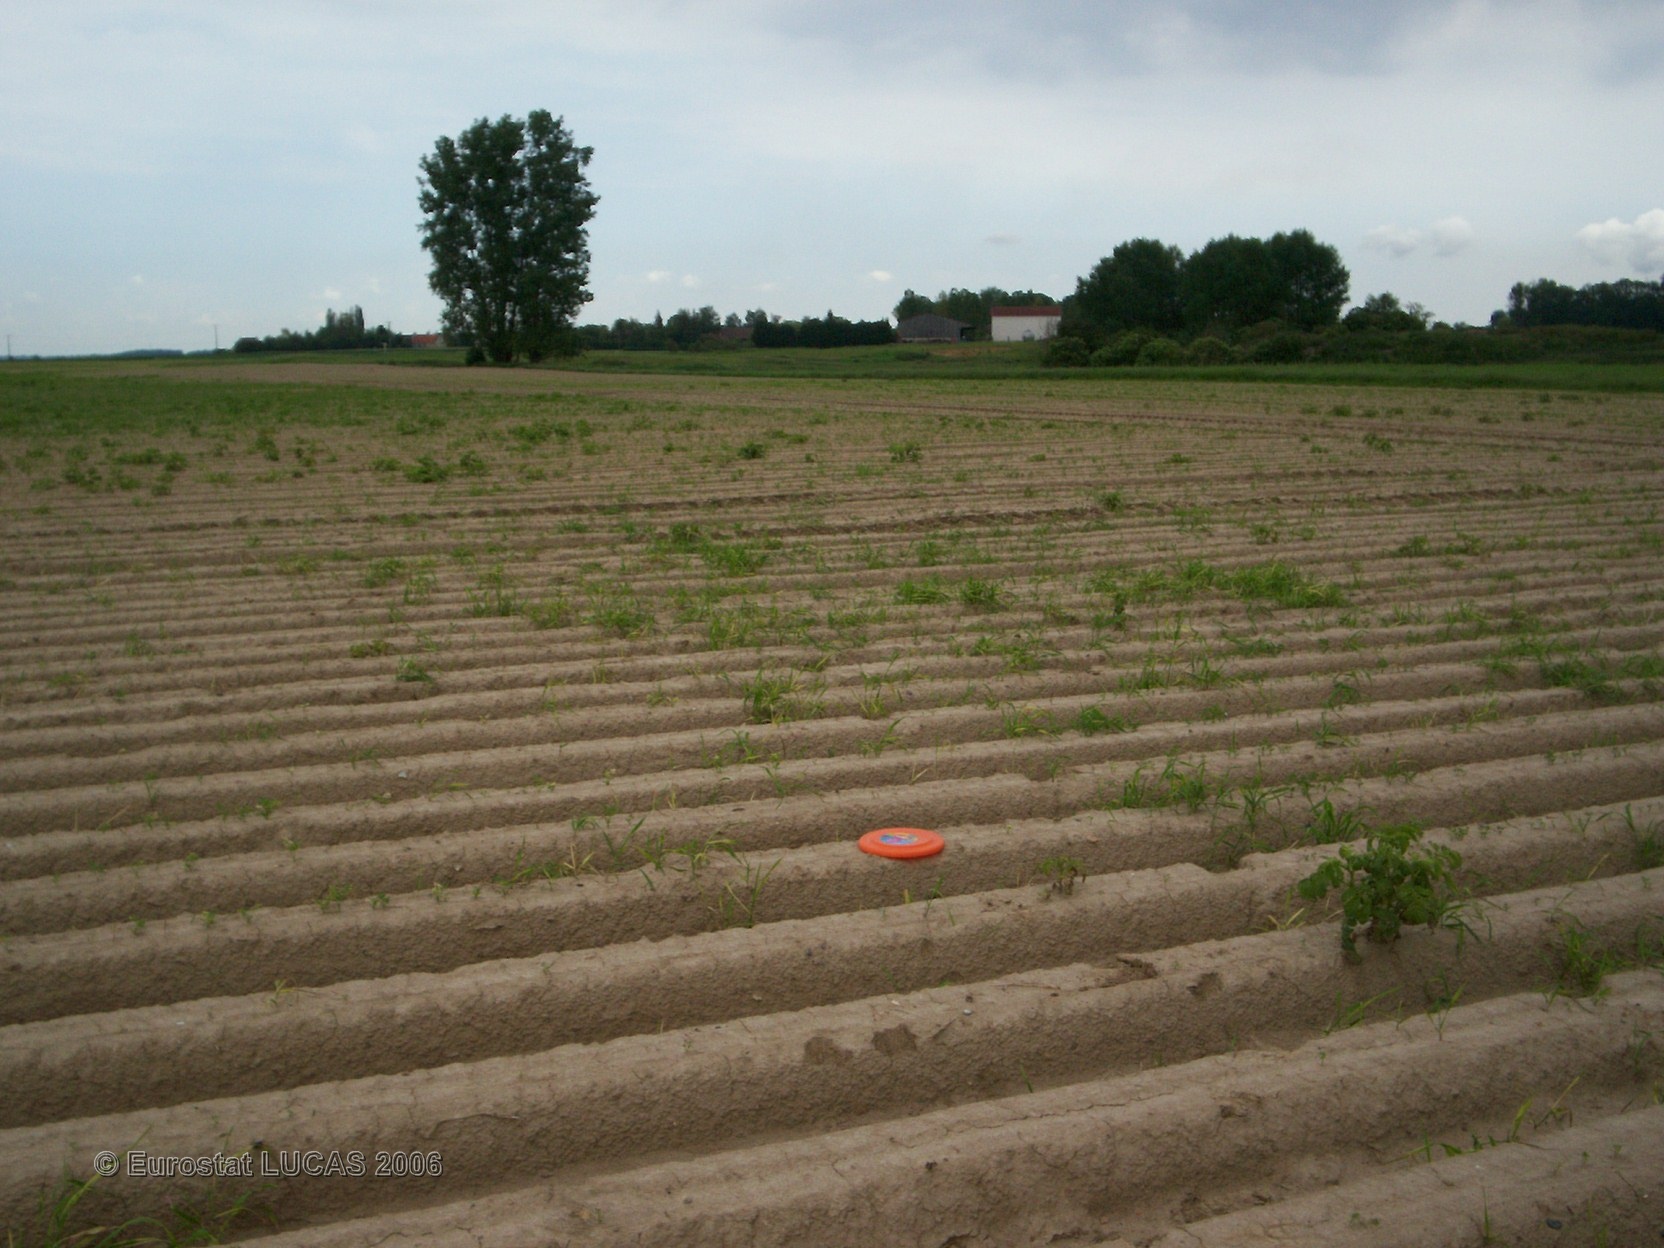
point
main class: Cropland
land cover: Other fresh vegetables
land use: Agriculture (excluding fallow land and kitchen gardens)
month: June
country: FR
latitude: 49.4601
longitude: 2.6628
